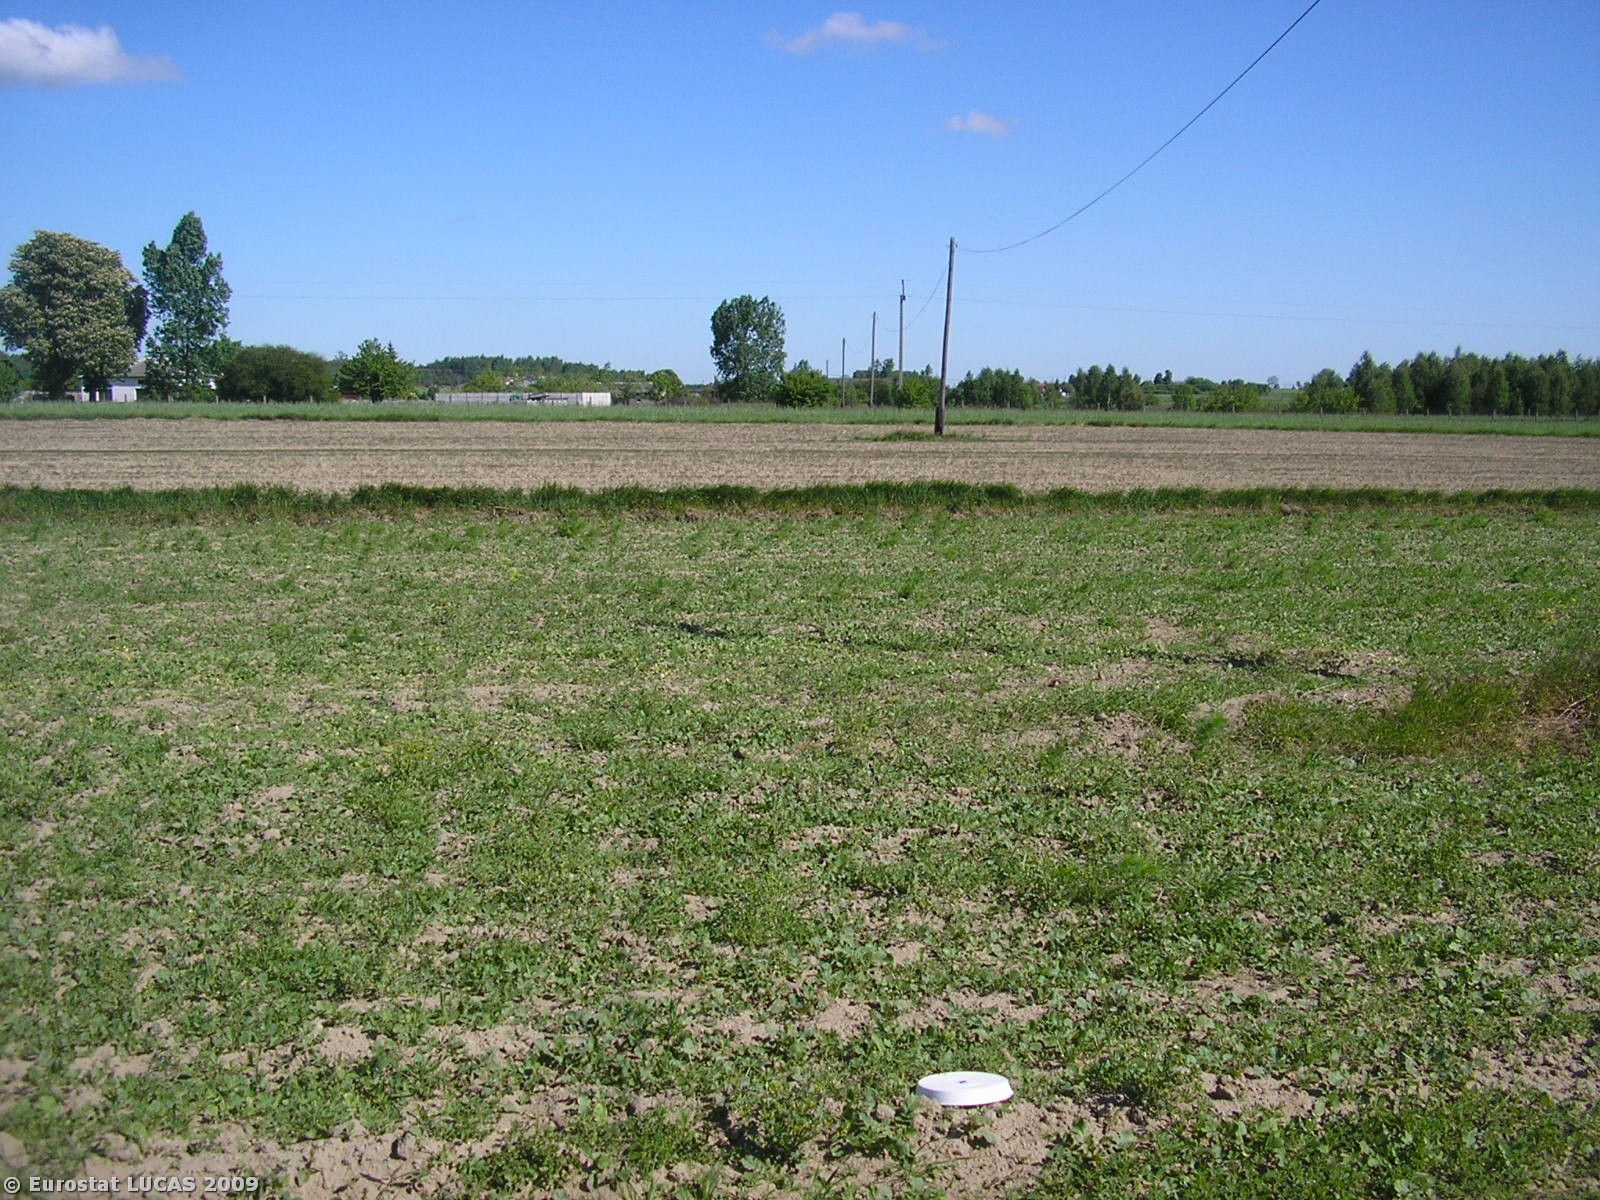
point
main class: Cropland
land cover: Other leguminous and mixtures for fodder
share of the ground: 10 - 25 %
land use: Agriculture (excluding fallow land and kitchen gardens)
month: May
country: PL
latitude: 51.6954
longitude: 20.0595
